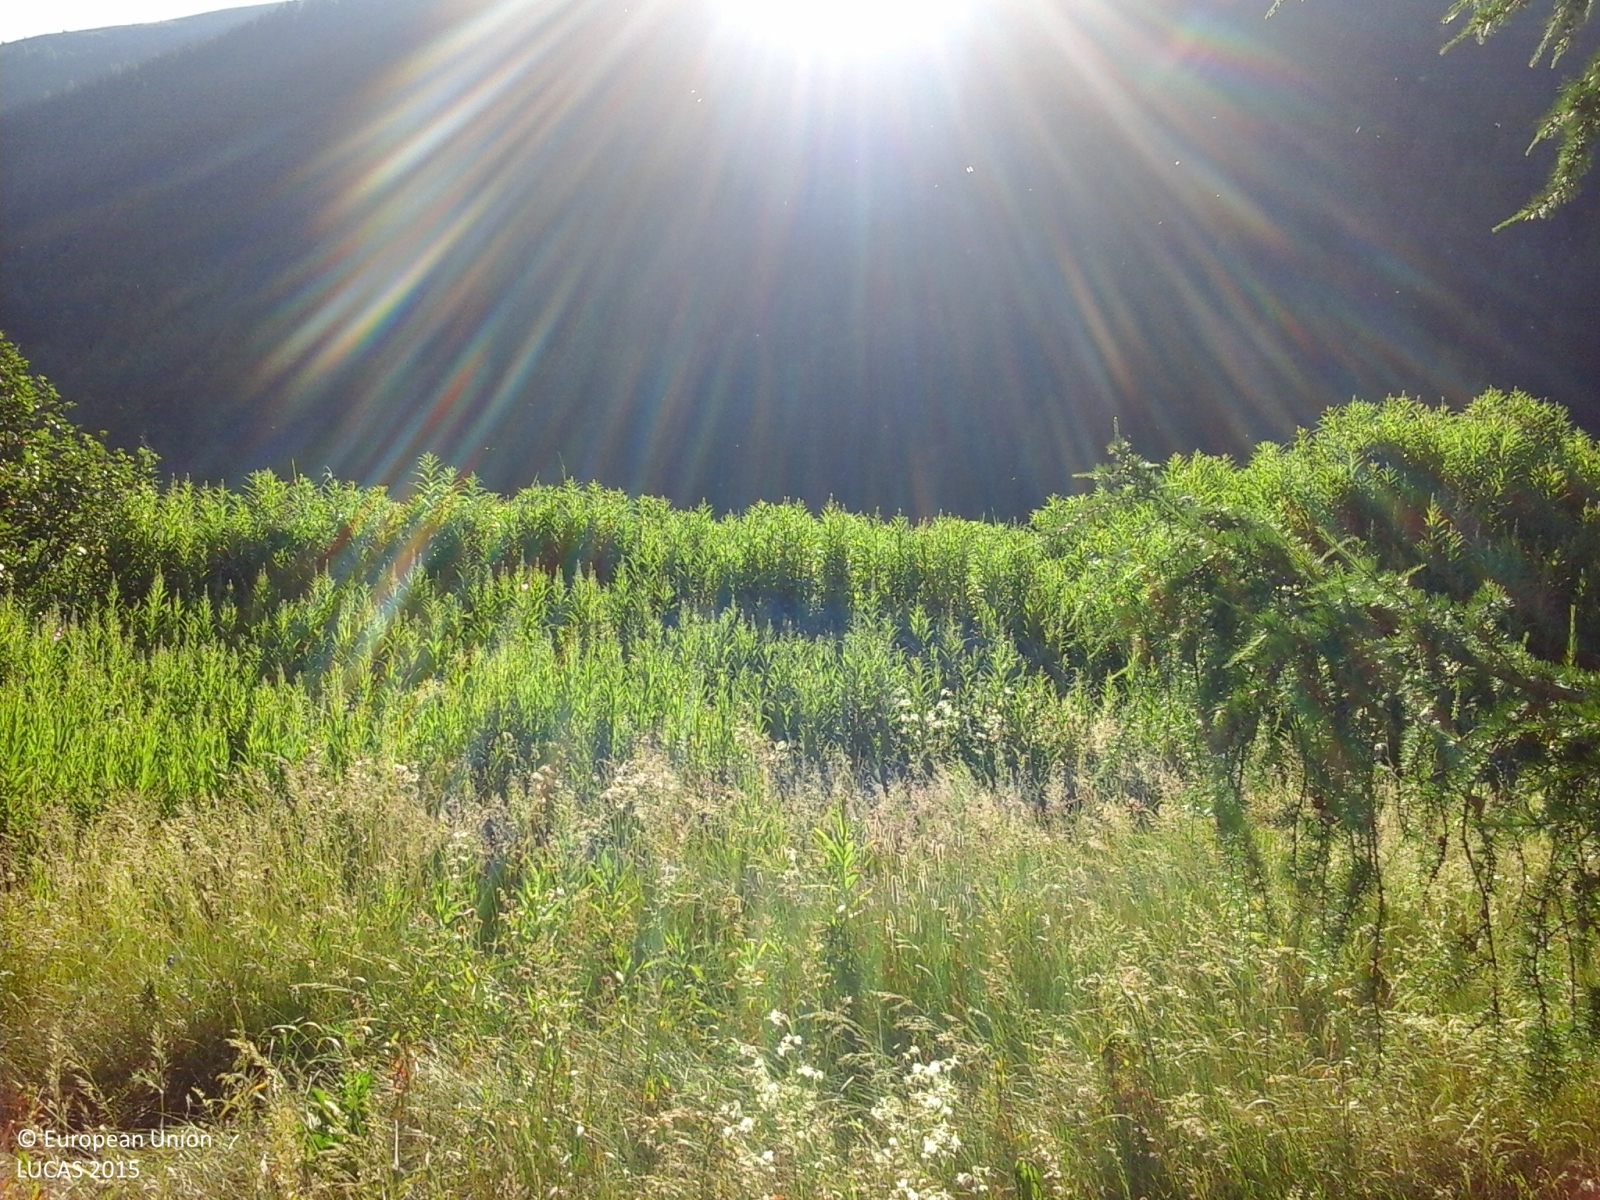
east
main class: Woodland
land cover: Other coniferous woodland
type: alpine coniferous forest
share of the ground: > 75 %
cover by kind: herbaceous plants 80 %, coniferous forest trees 20 %
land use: Agriculture (excluding fallow land and kitchen gardens)
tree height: > 5 m
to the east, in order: Other coniferous woodland; Artificial constructions; Grassland without tree/shrub cover; Fences; Grassland without tree/shrub cover; Fences; Grassland without tree/shrub cover; Artificial constructions in urban areas; Grassland with sparse tree/shrub cover; Fences; Spruce dominated coniferous woodland
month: July
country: IT
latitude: 46.4952
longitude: 10.1171
